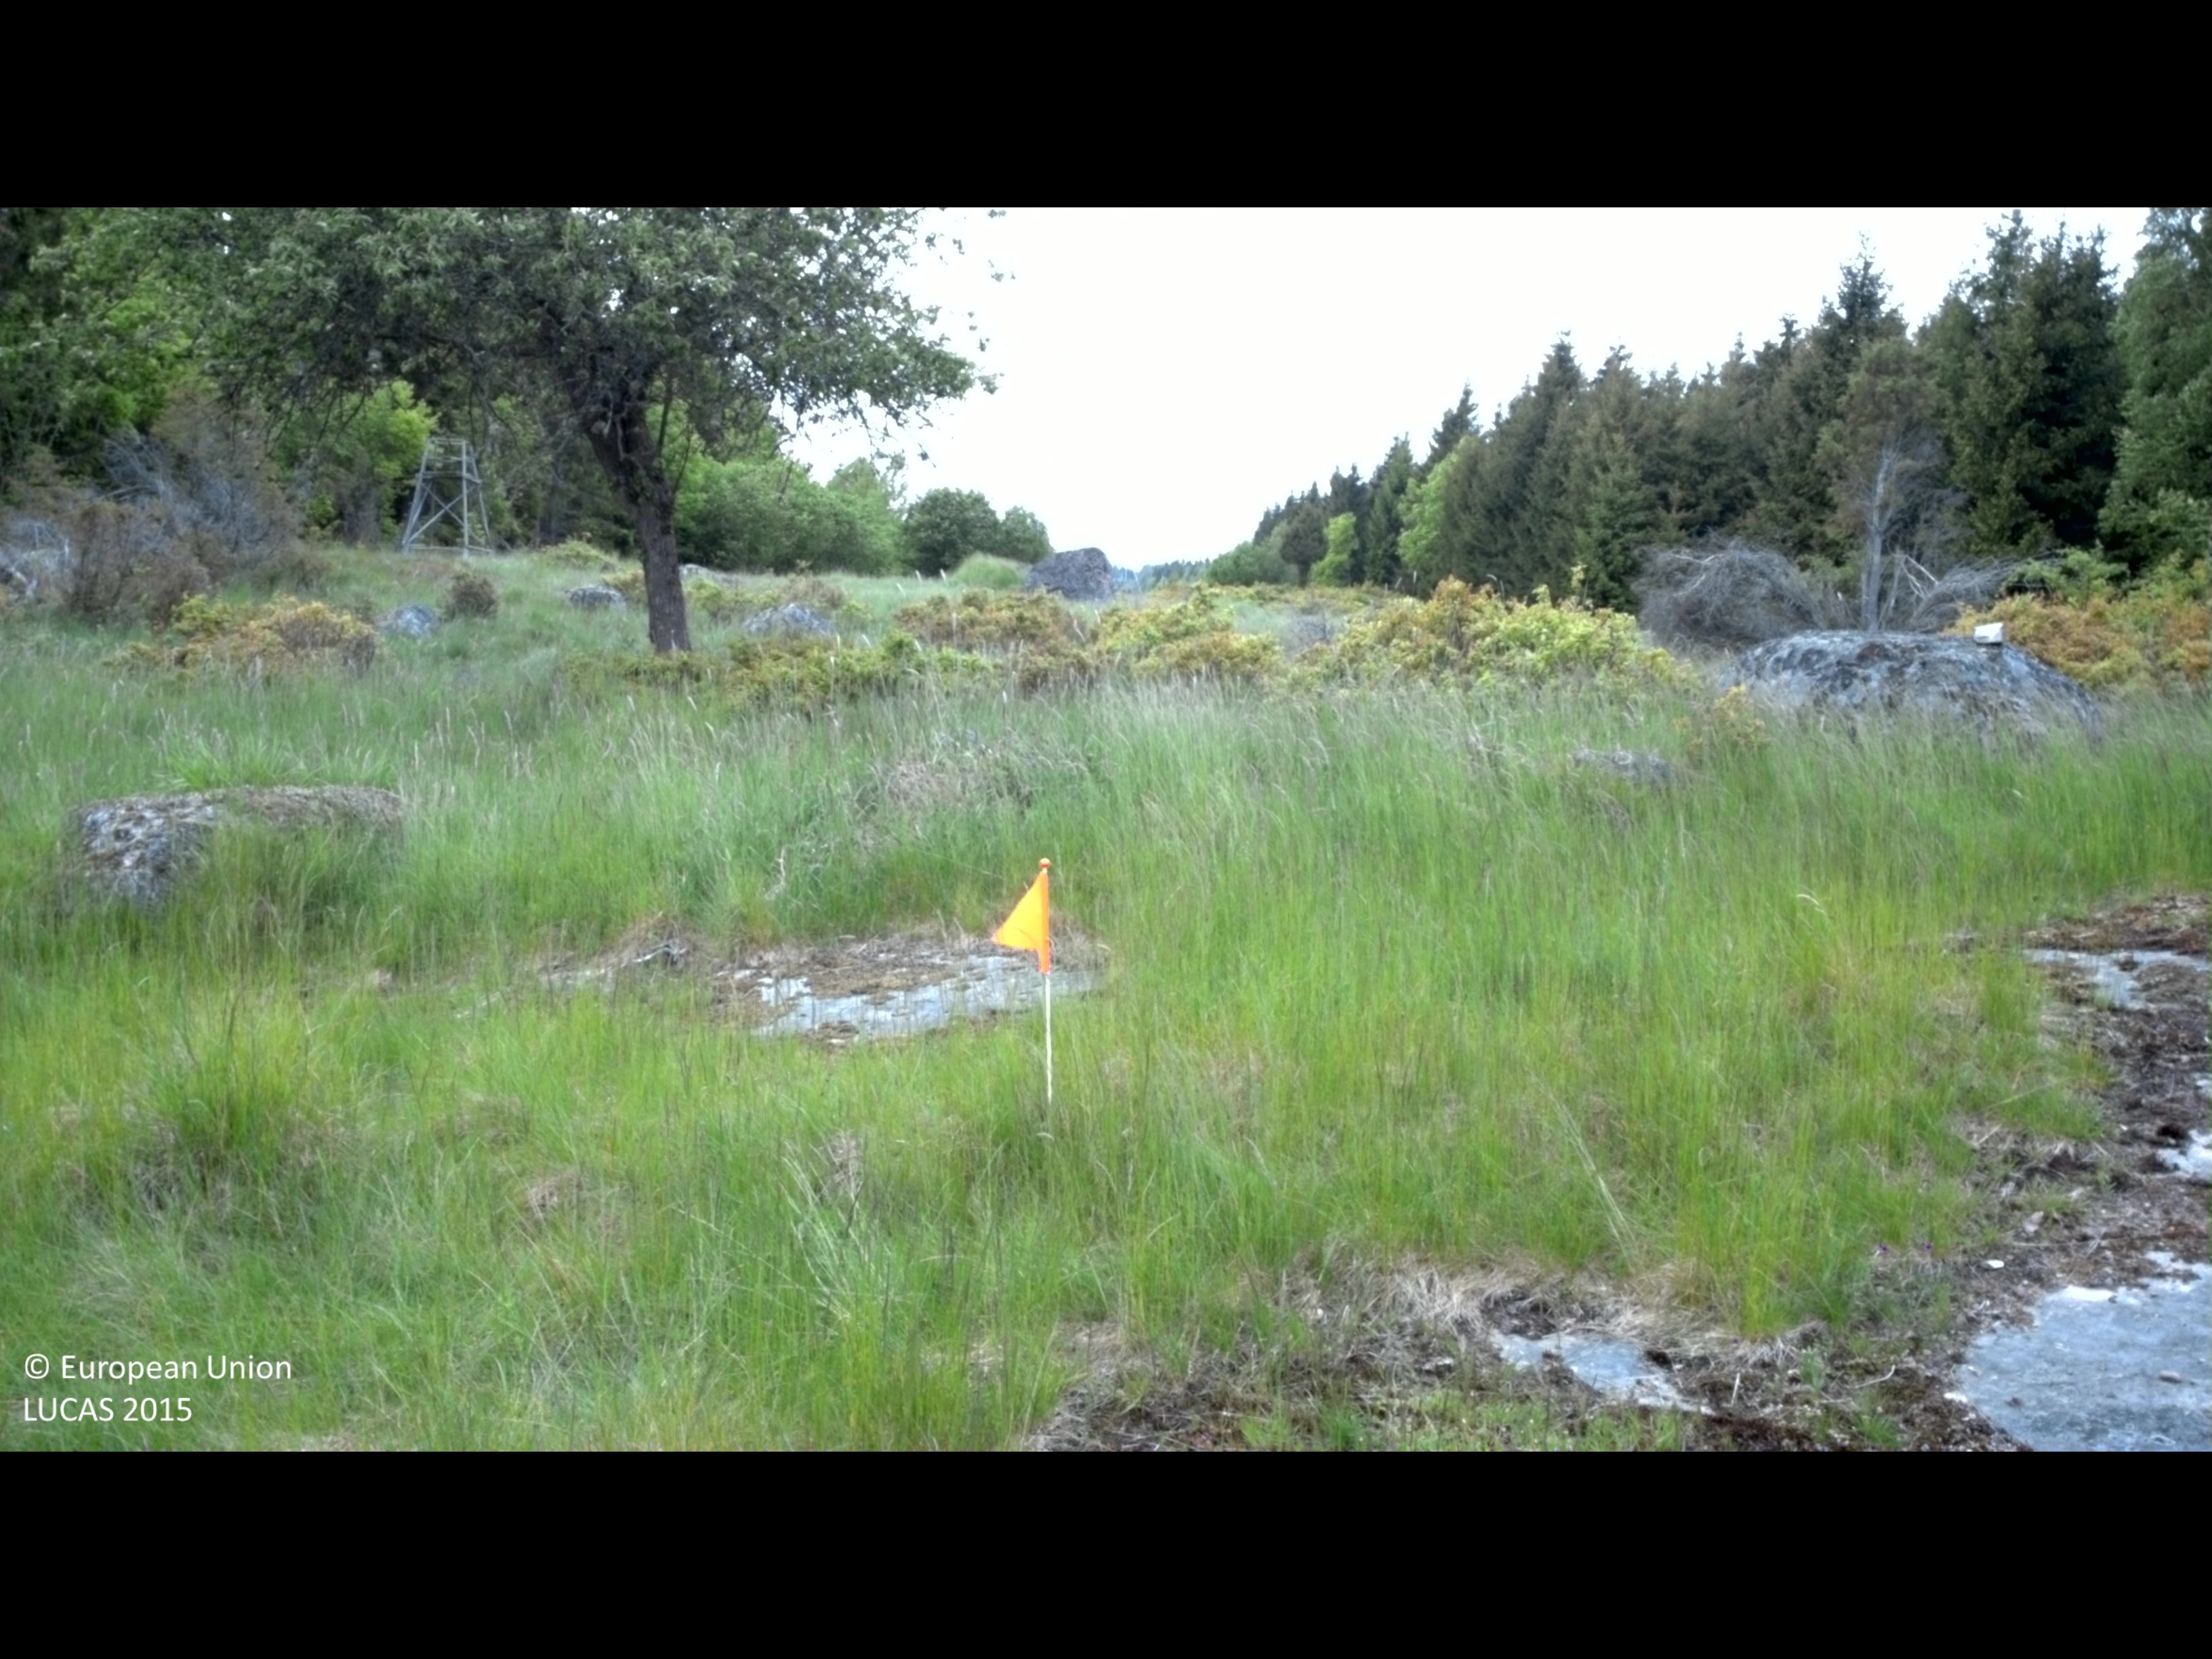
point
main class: Artificial land
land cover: Other artificial areas
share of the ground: > 75 %
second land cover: Grassland with sparse tree/shrub cover
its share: > 75 %
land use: Electricity, gas and thermal power distribution
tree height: > 5 m
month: June
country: SE
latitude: 57.7260
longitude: 16.3620
